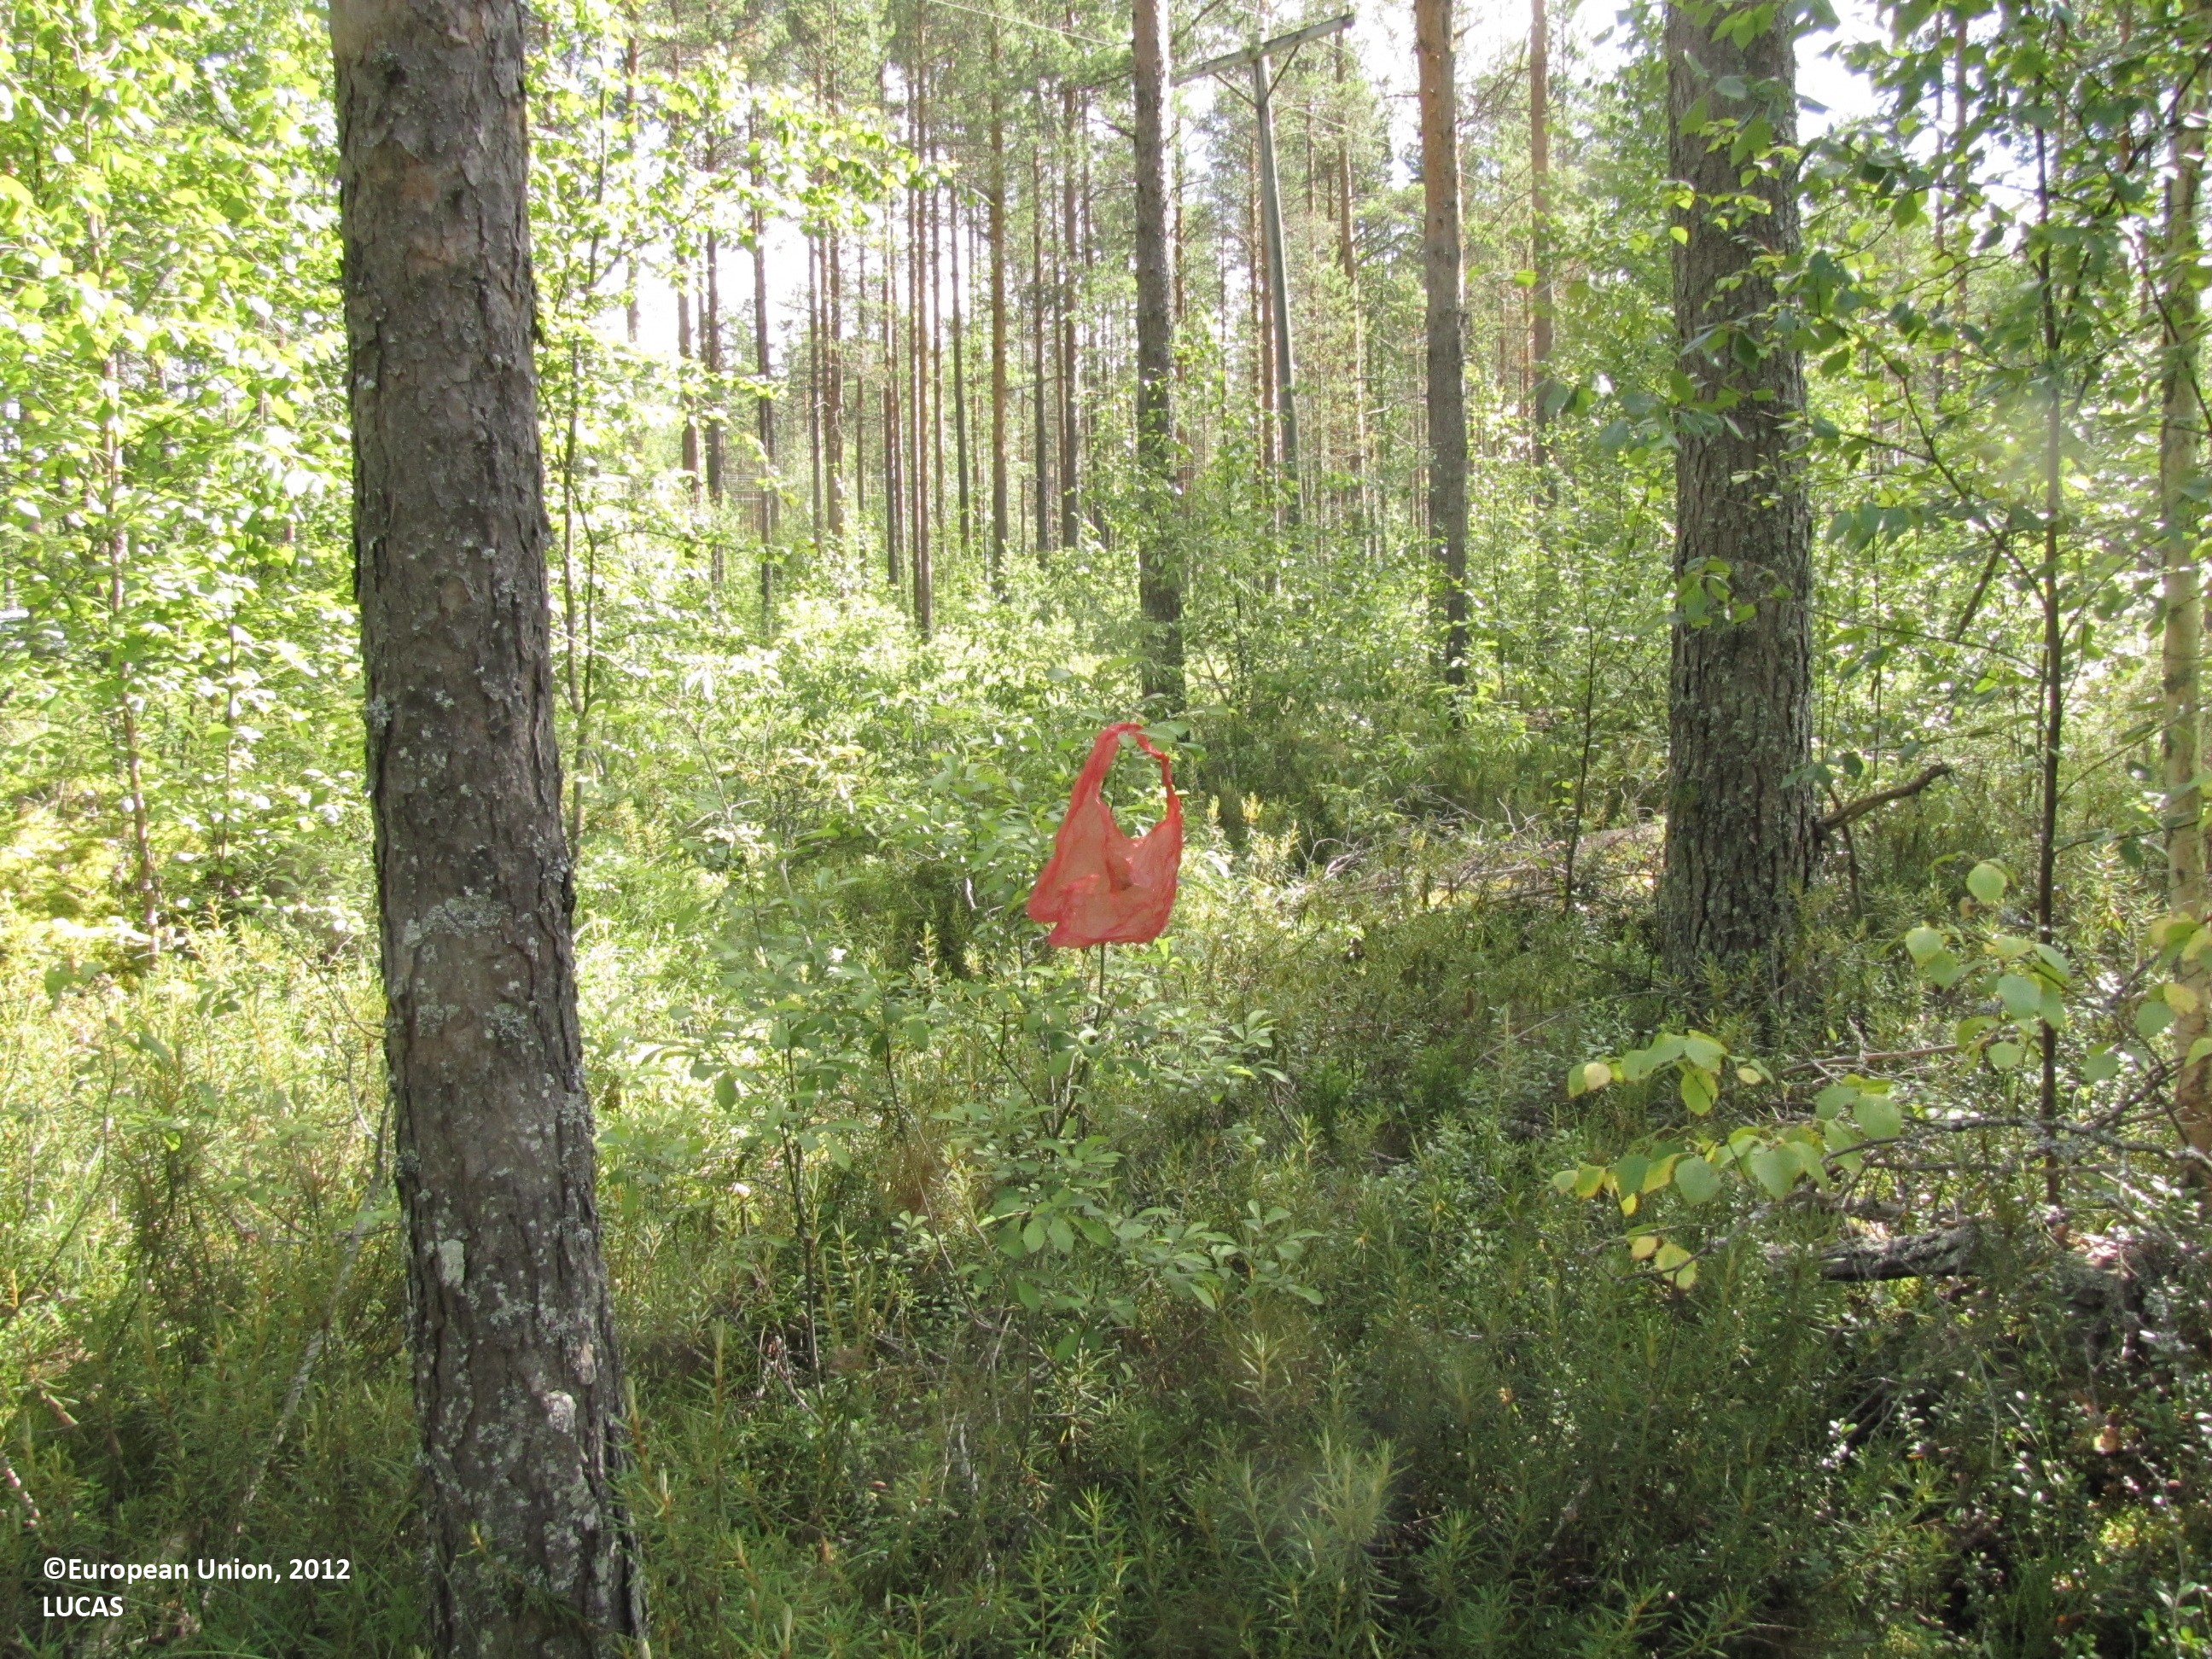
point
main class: Woodland
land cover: Pine dominated coniferous woodland
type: boreal forest
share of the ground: 50 - 75 %
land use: Forestry
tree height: > 5 m
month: July
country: FI
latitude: 62.4398
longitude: 23.1035
